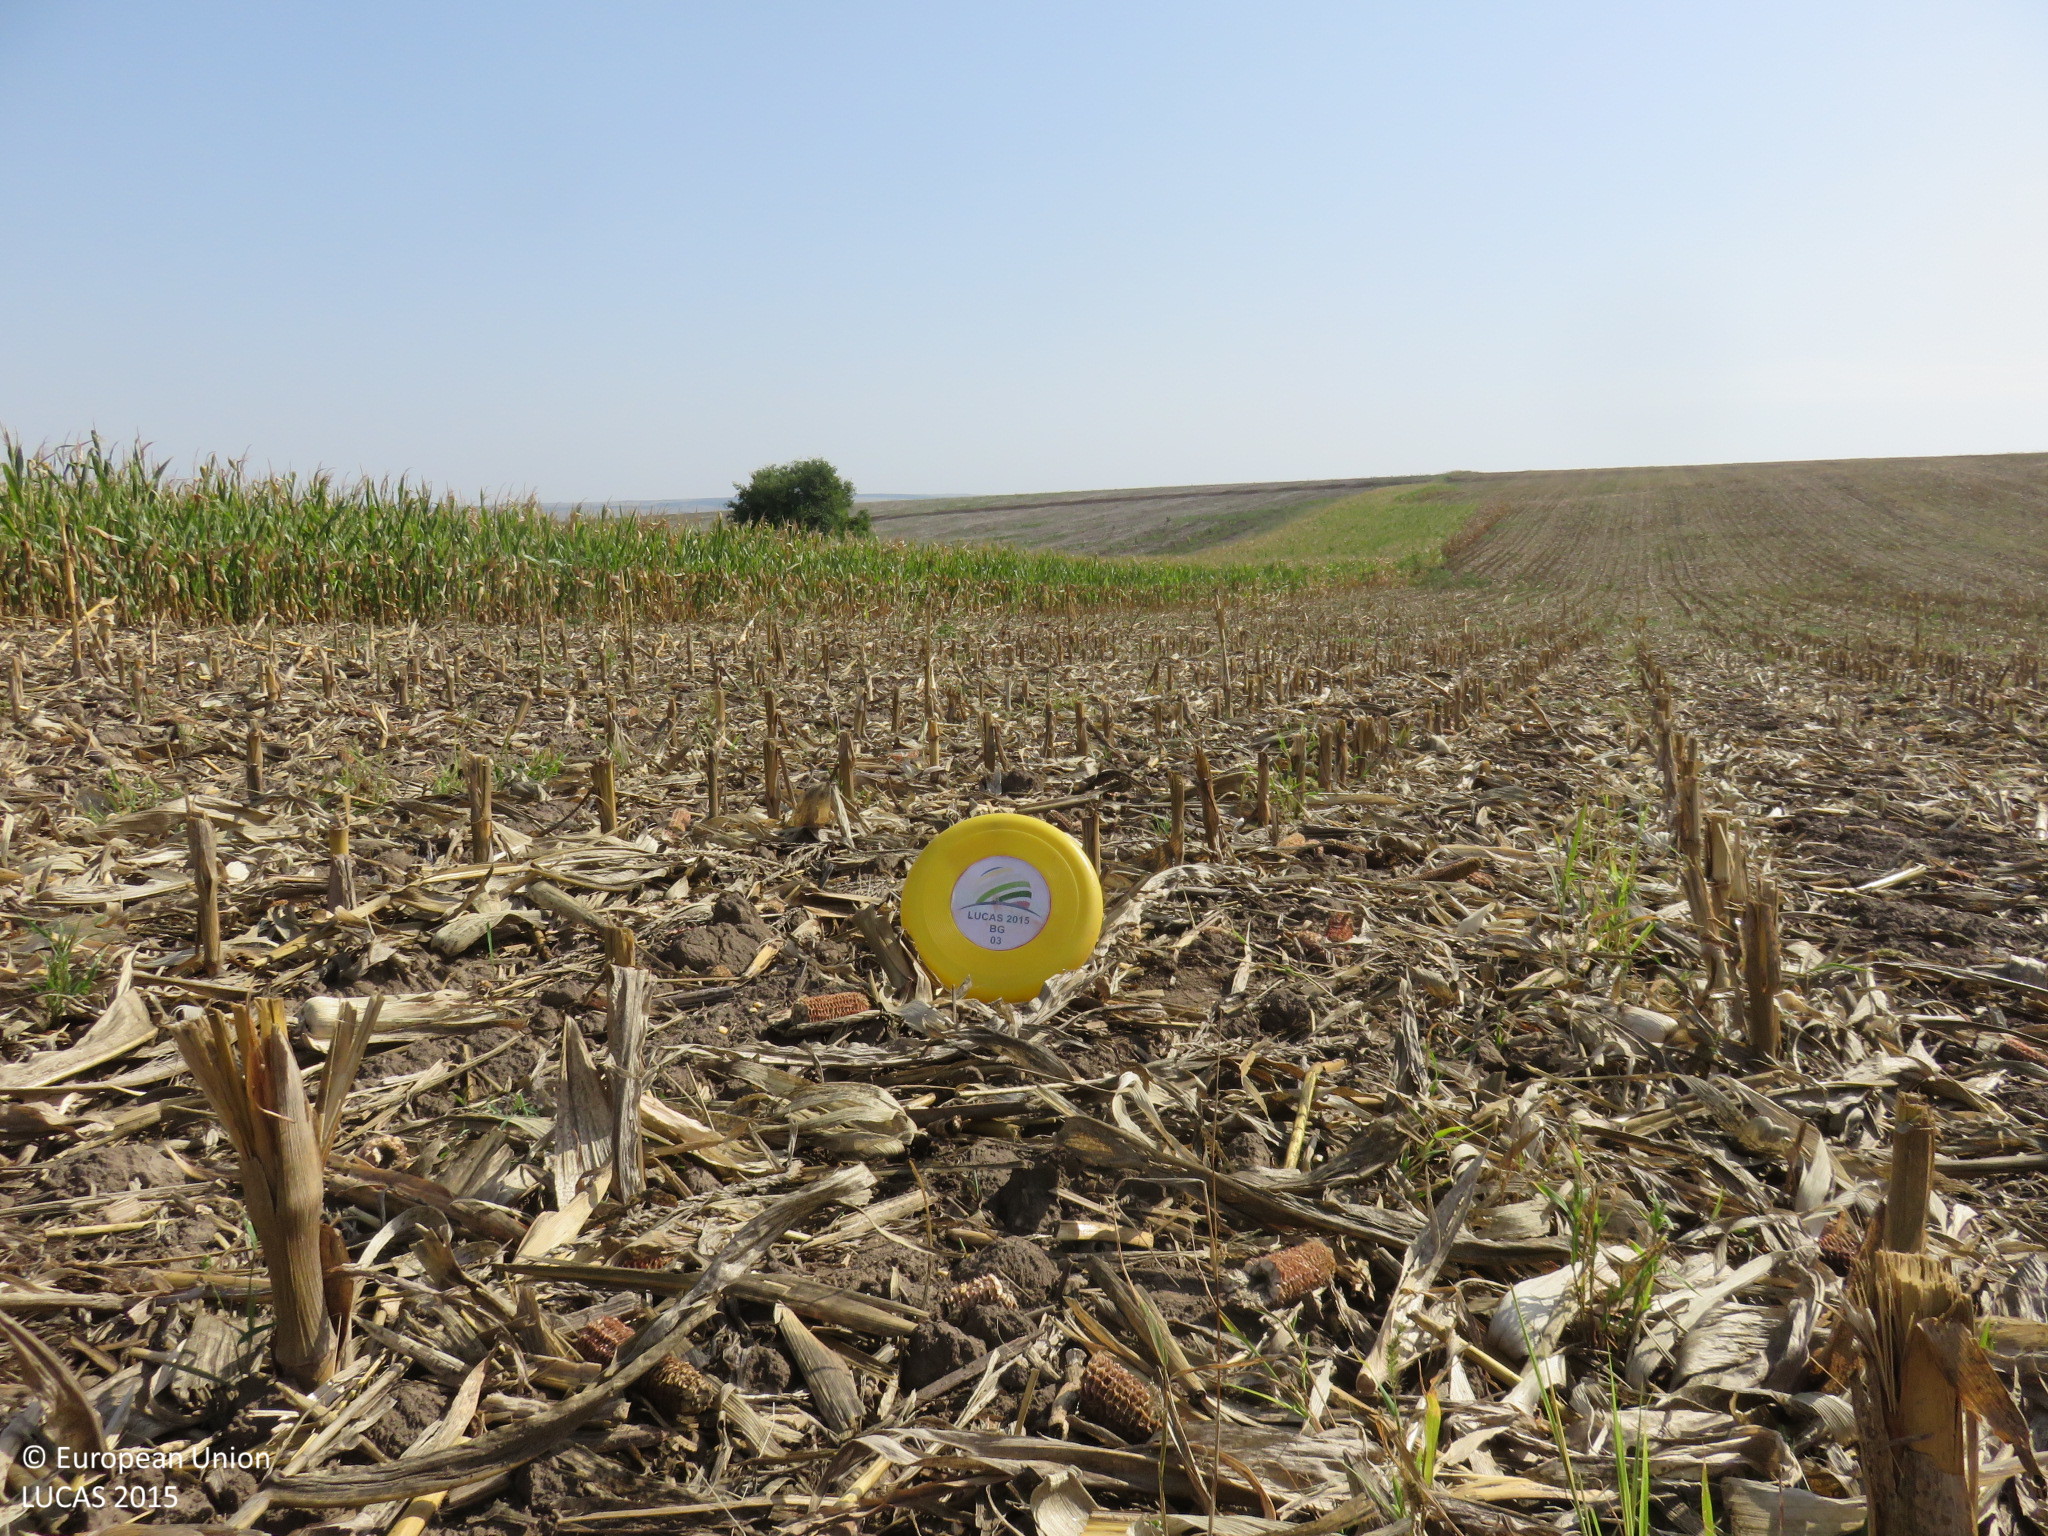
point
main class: Cropland
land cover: Maize
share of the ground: > 75 %
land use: Agriculture (excluding fallow land and kitchen gardens)
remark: Harvested field
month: September
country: BG
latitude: 43.5730
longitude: 24.5633
